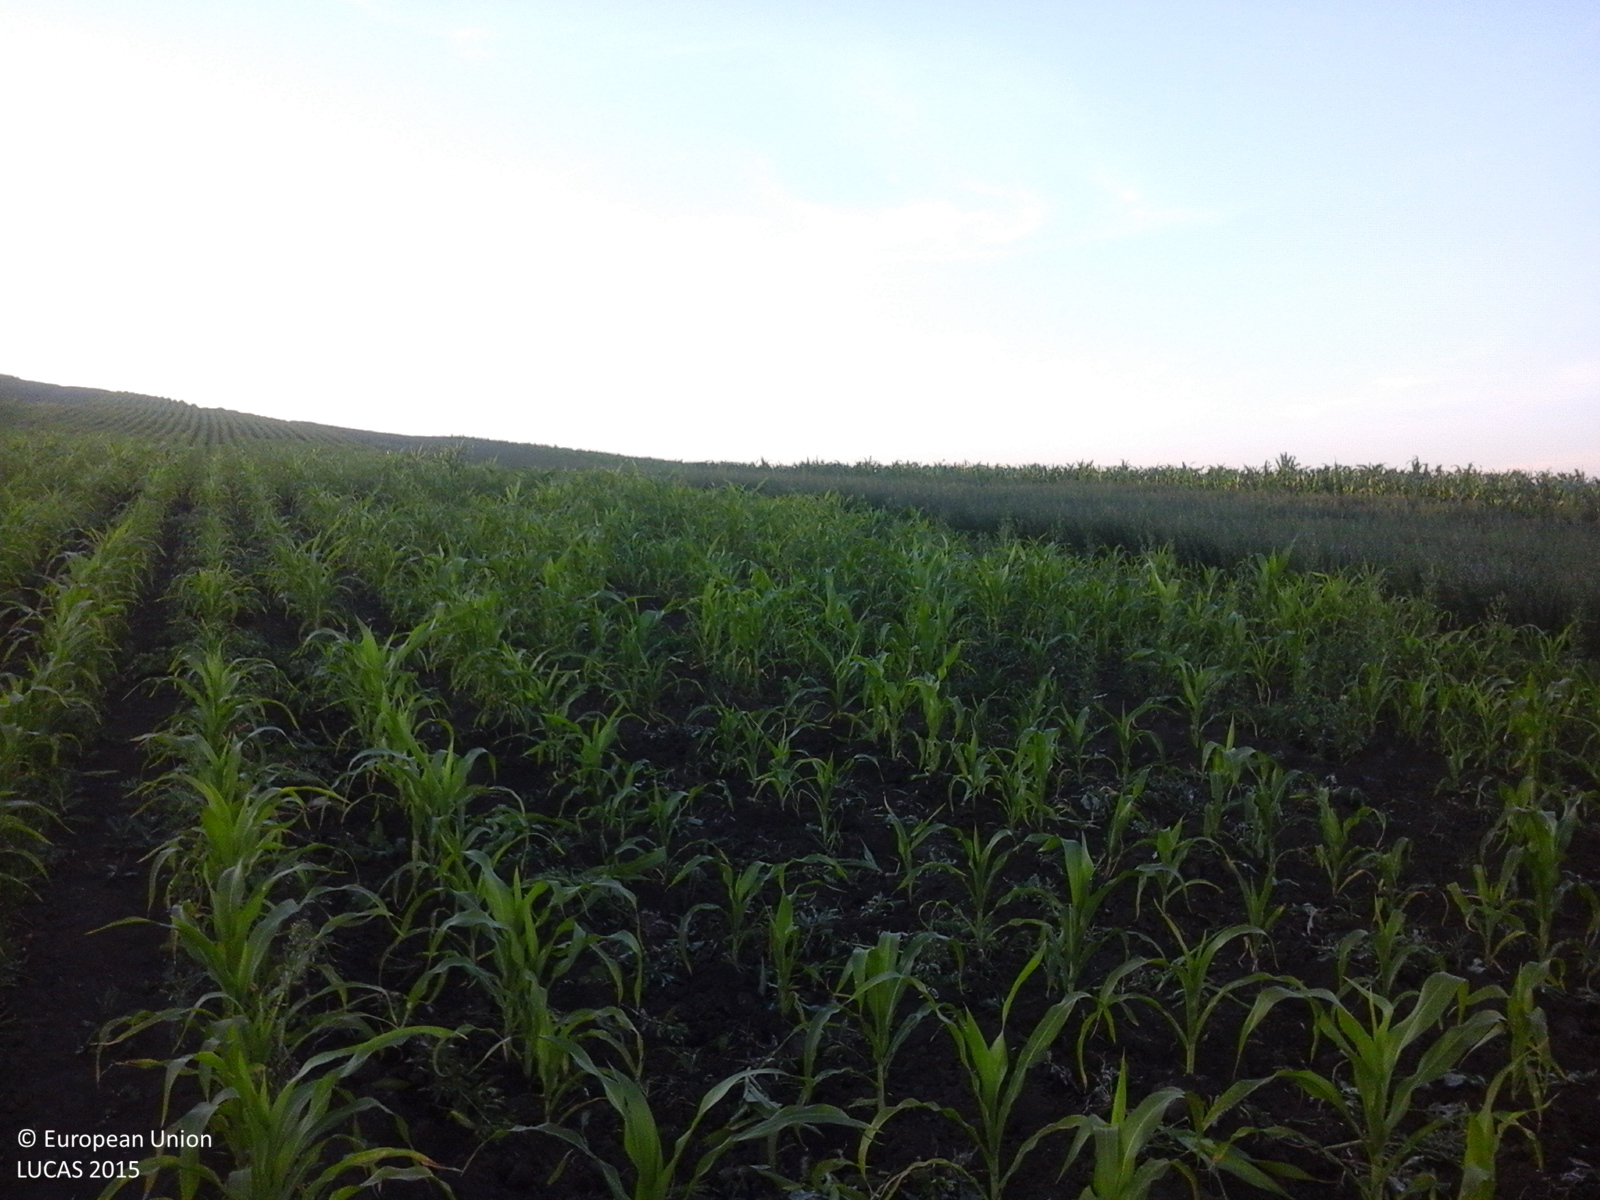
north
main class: Cropland
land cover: Maize
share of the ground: 50 - 75 %
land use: Agriculture (excluding fallow land and kitchen gardens)
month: June
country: RO
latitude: 47.1628
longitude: 27.1346
